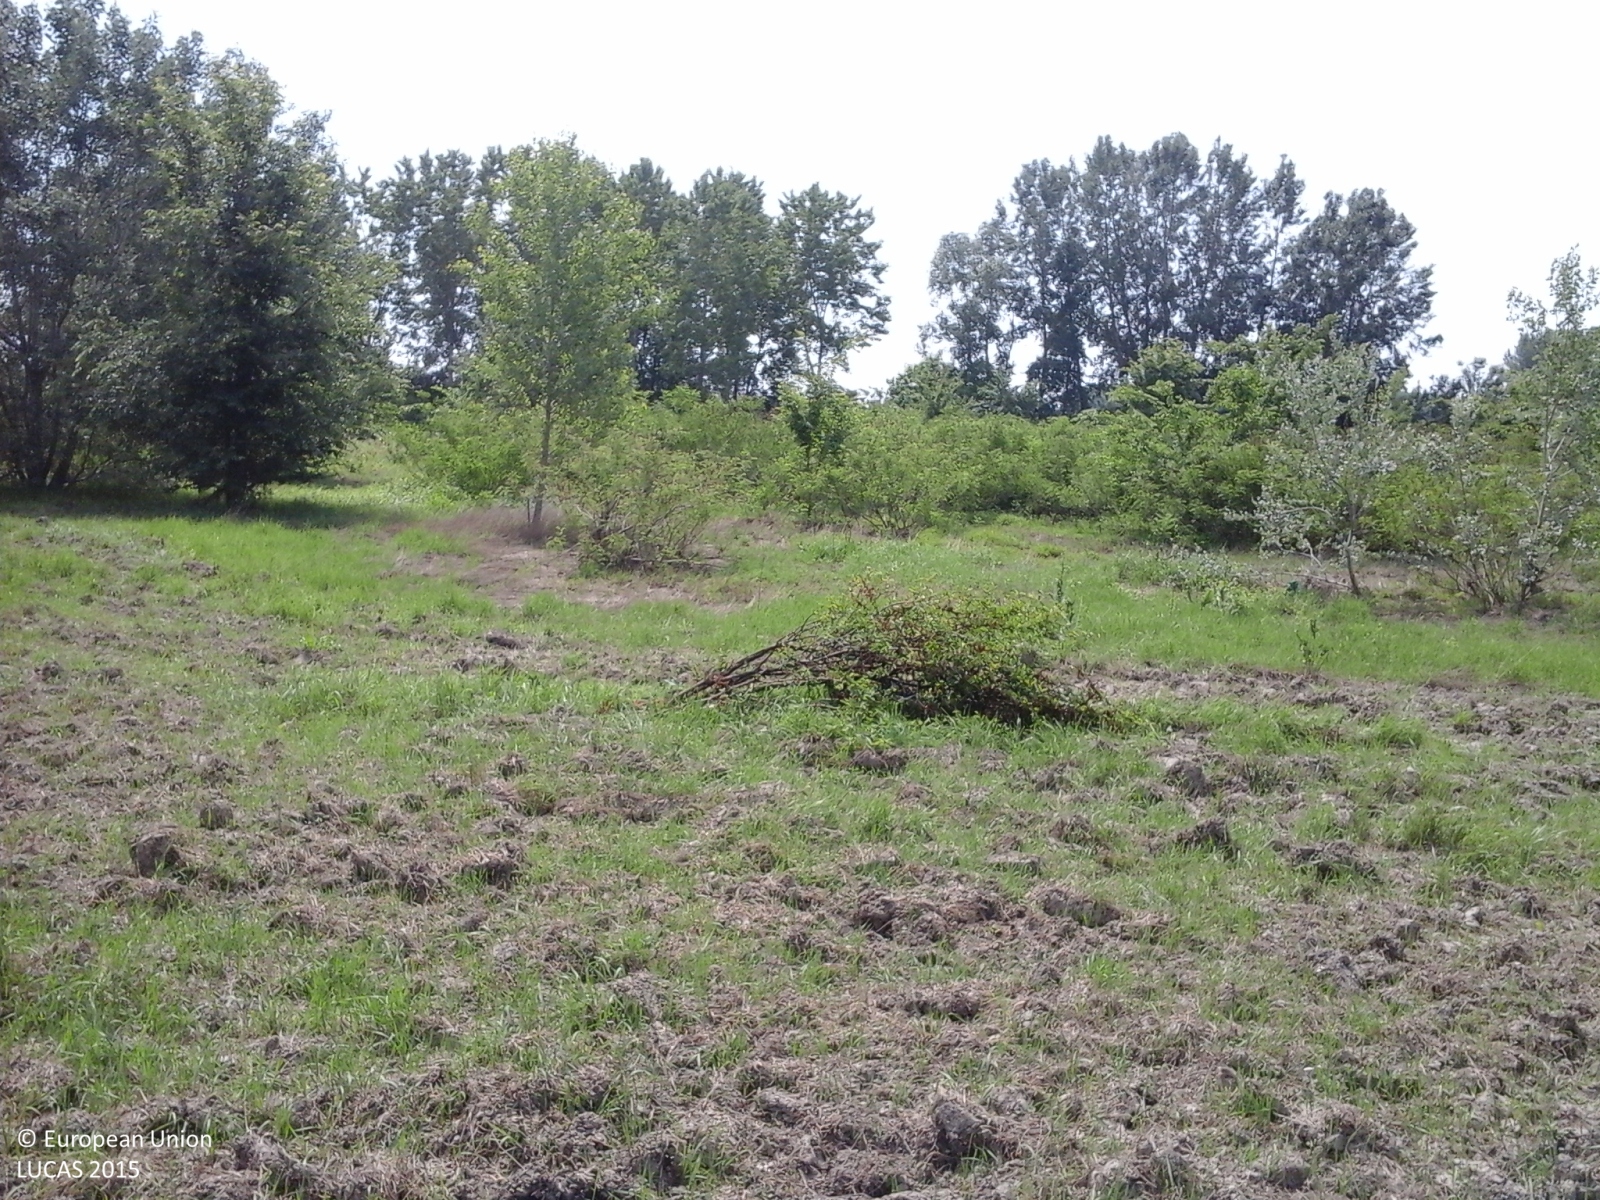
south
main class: Grassland
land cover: Spontaneously vegetated surfaces
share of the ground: 50 - 75 %
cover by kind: herbaceous plants 55 %, unconsolidated bare surface 45 %
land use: Fallow land
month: May
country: IT
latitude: 44.9077
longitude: 10.6194
